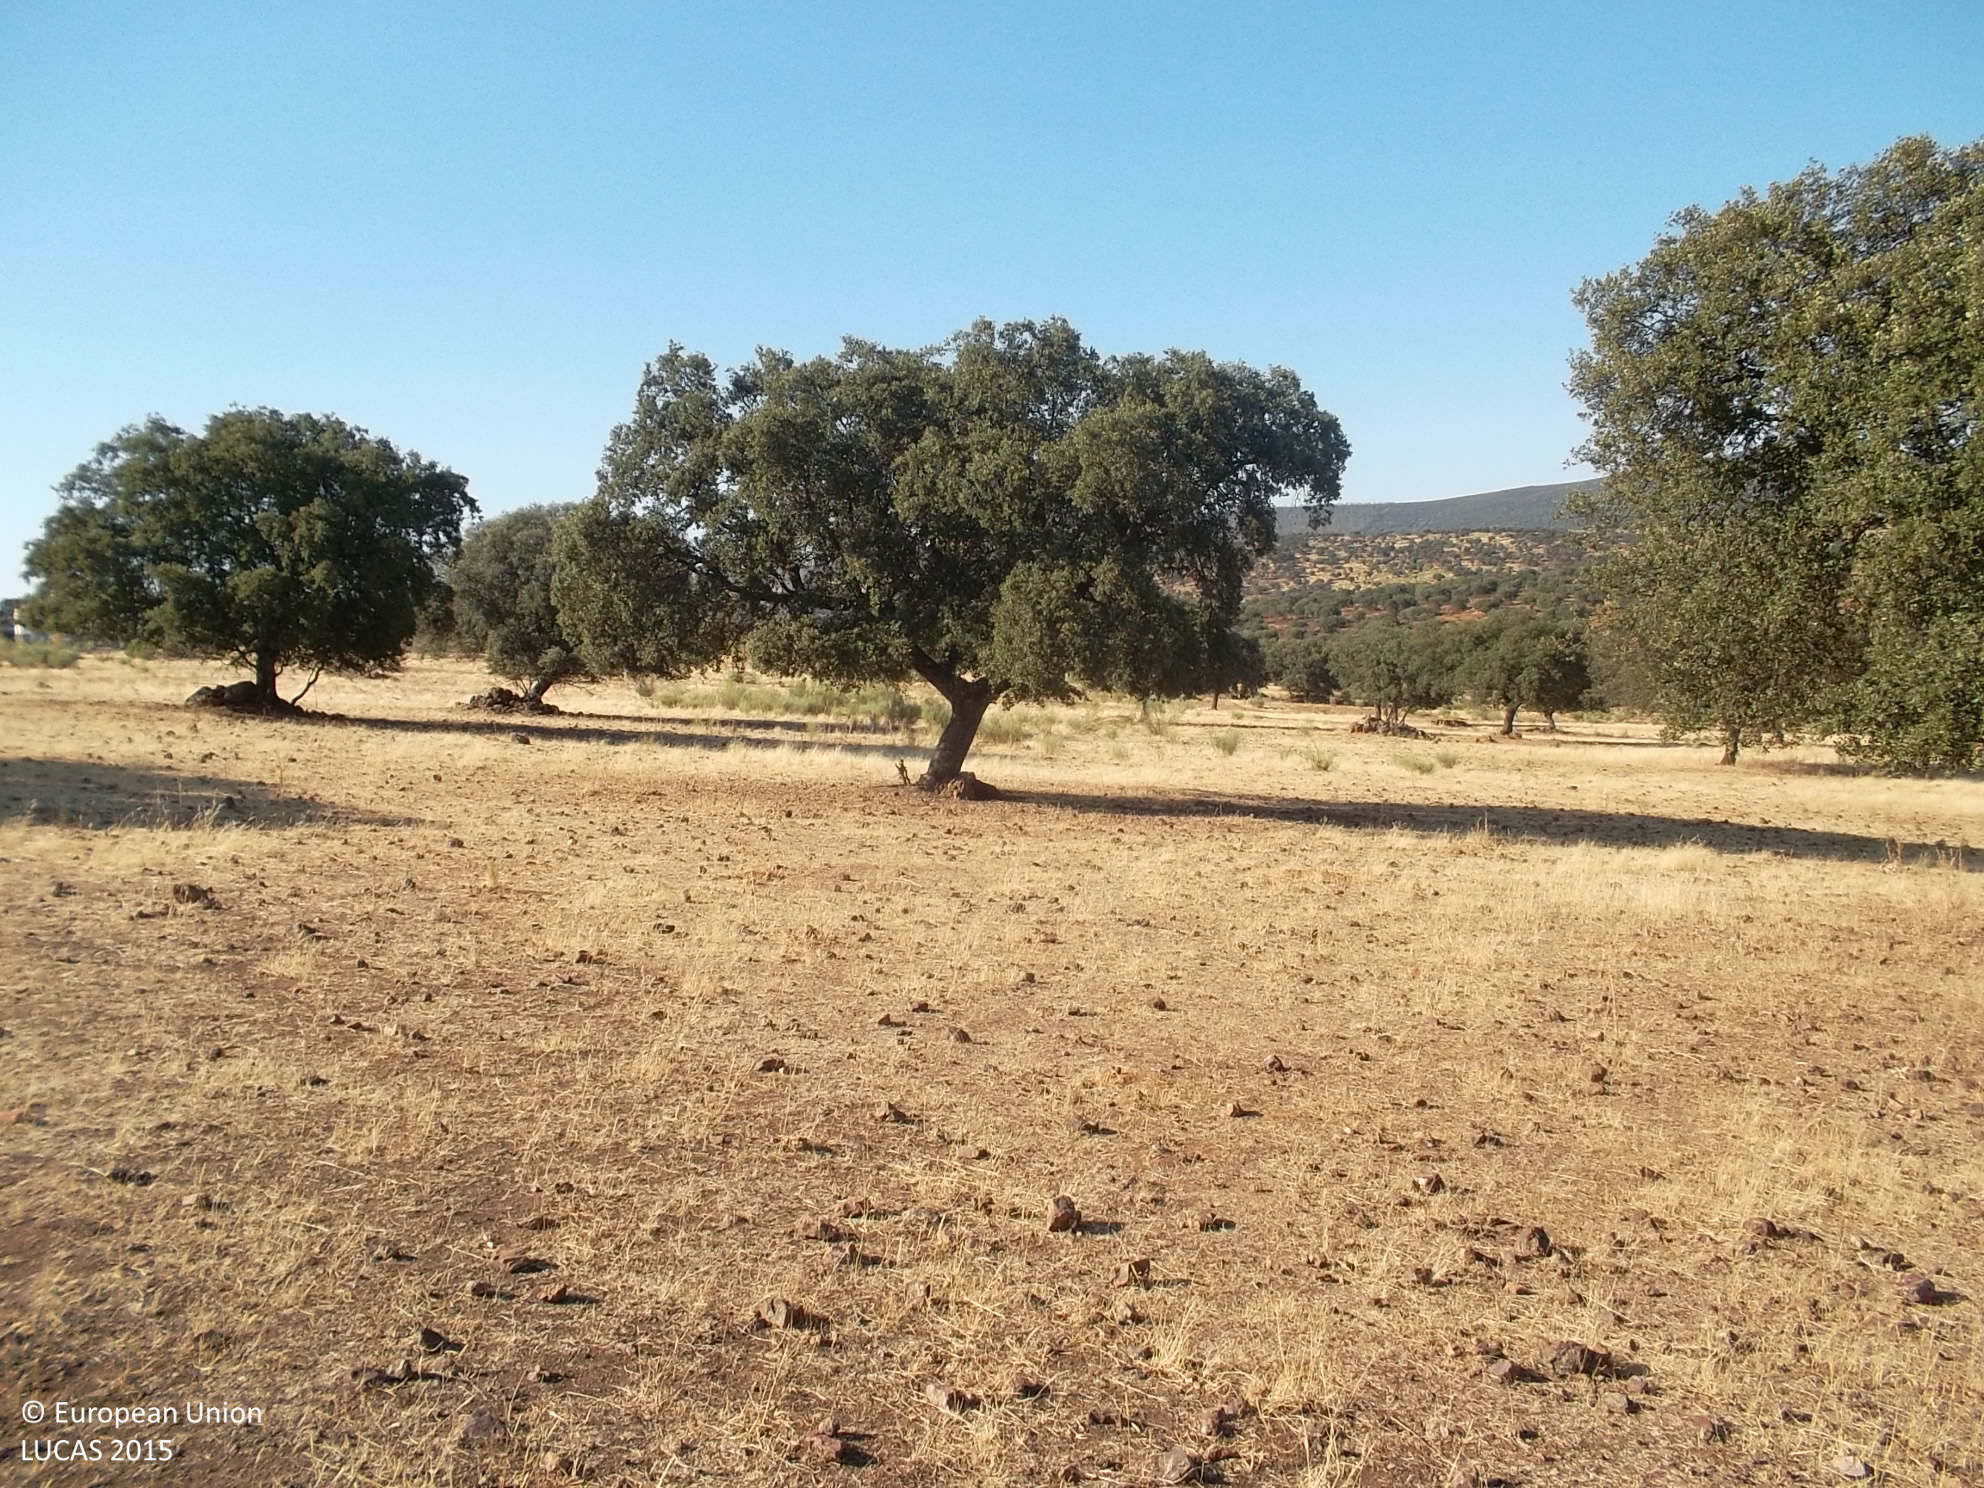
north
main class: Grassland
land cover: Grassland without tree/shrub cover
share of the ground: > 75 %
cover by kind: herbaceous plants 100 %
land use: Agriculture (excluding fallow land and kitchen gardens)
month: July
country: ES
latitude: 38.5412
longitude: -5.7700
